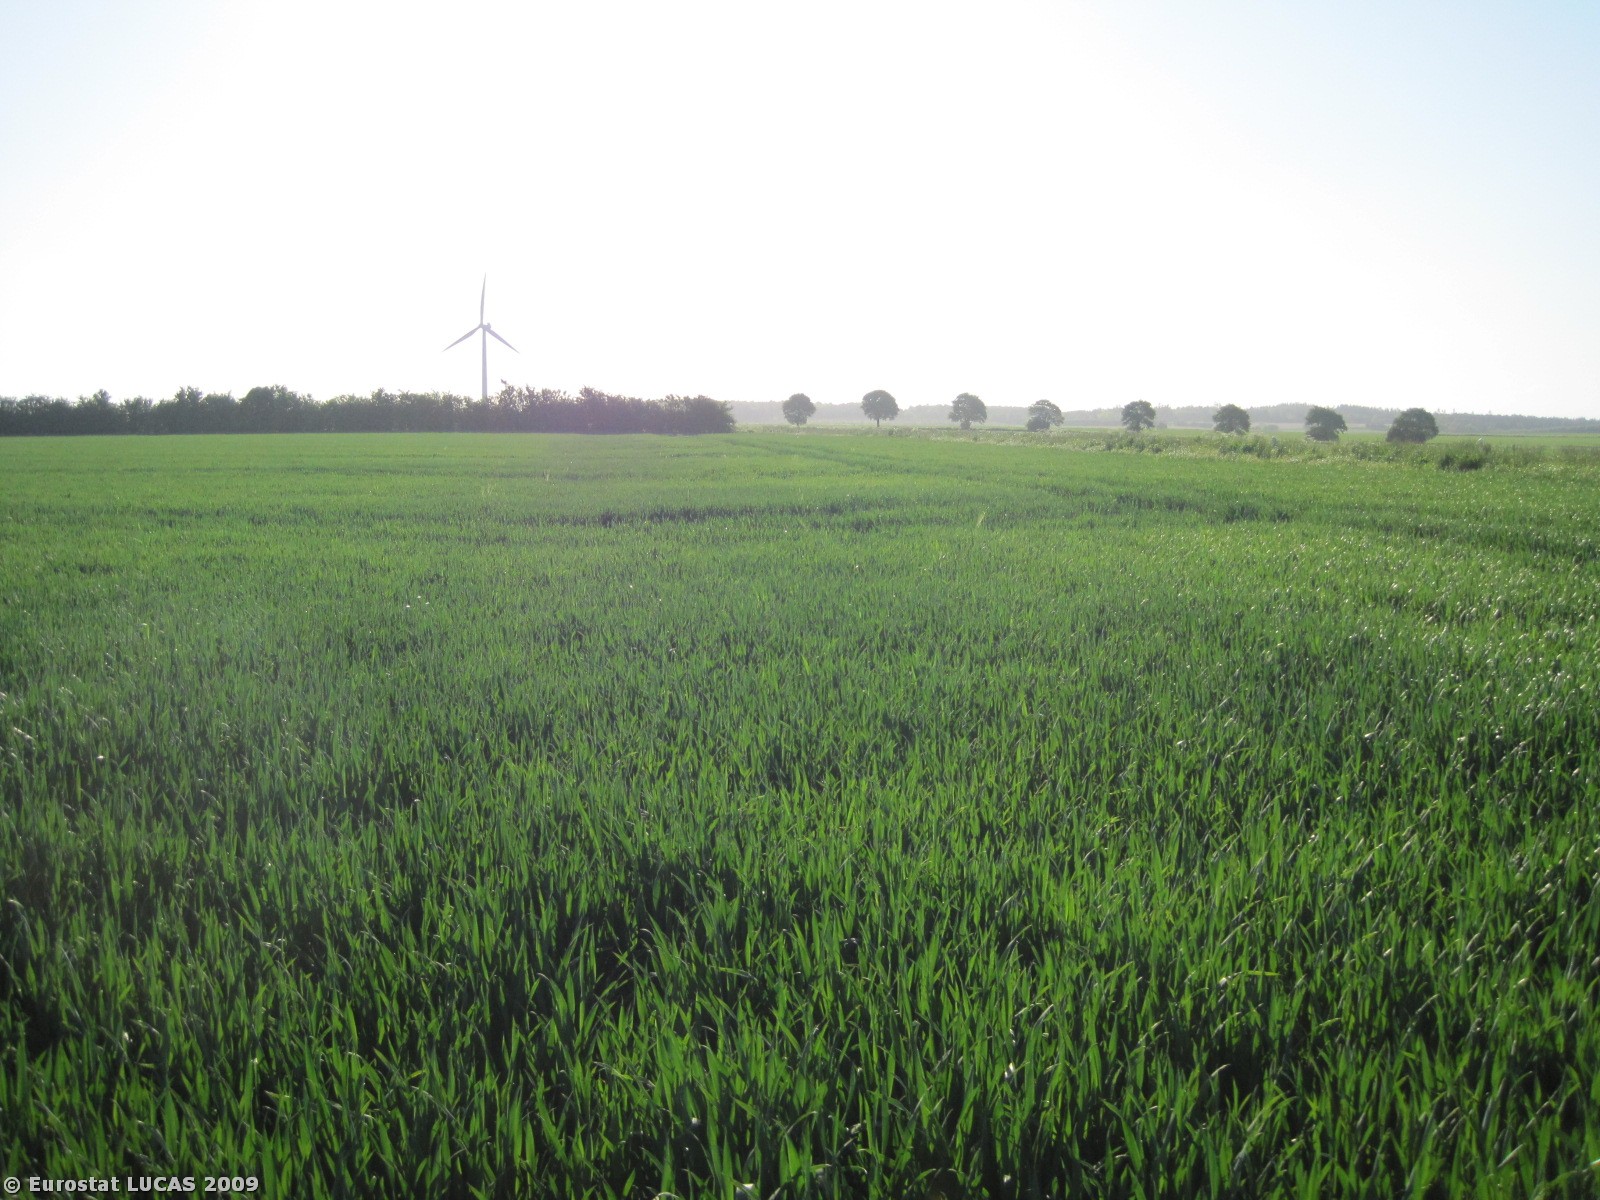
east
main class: Cropland
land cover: Common wheat
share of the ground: > 75 %
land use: Agriculture (excluding fallow land and kitchen gardens)
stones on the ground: < 10 %
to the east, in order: Common wheat; Grass margins; Tracks; Grass margins; Barley
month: May
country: DK
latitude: 56.6190
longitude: 10.2116
